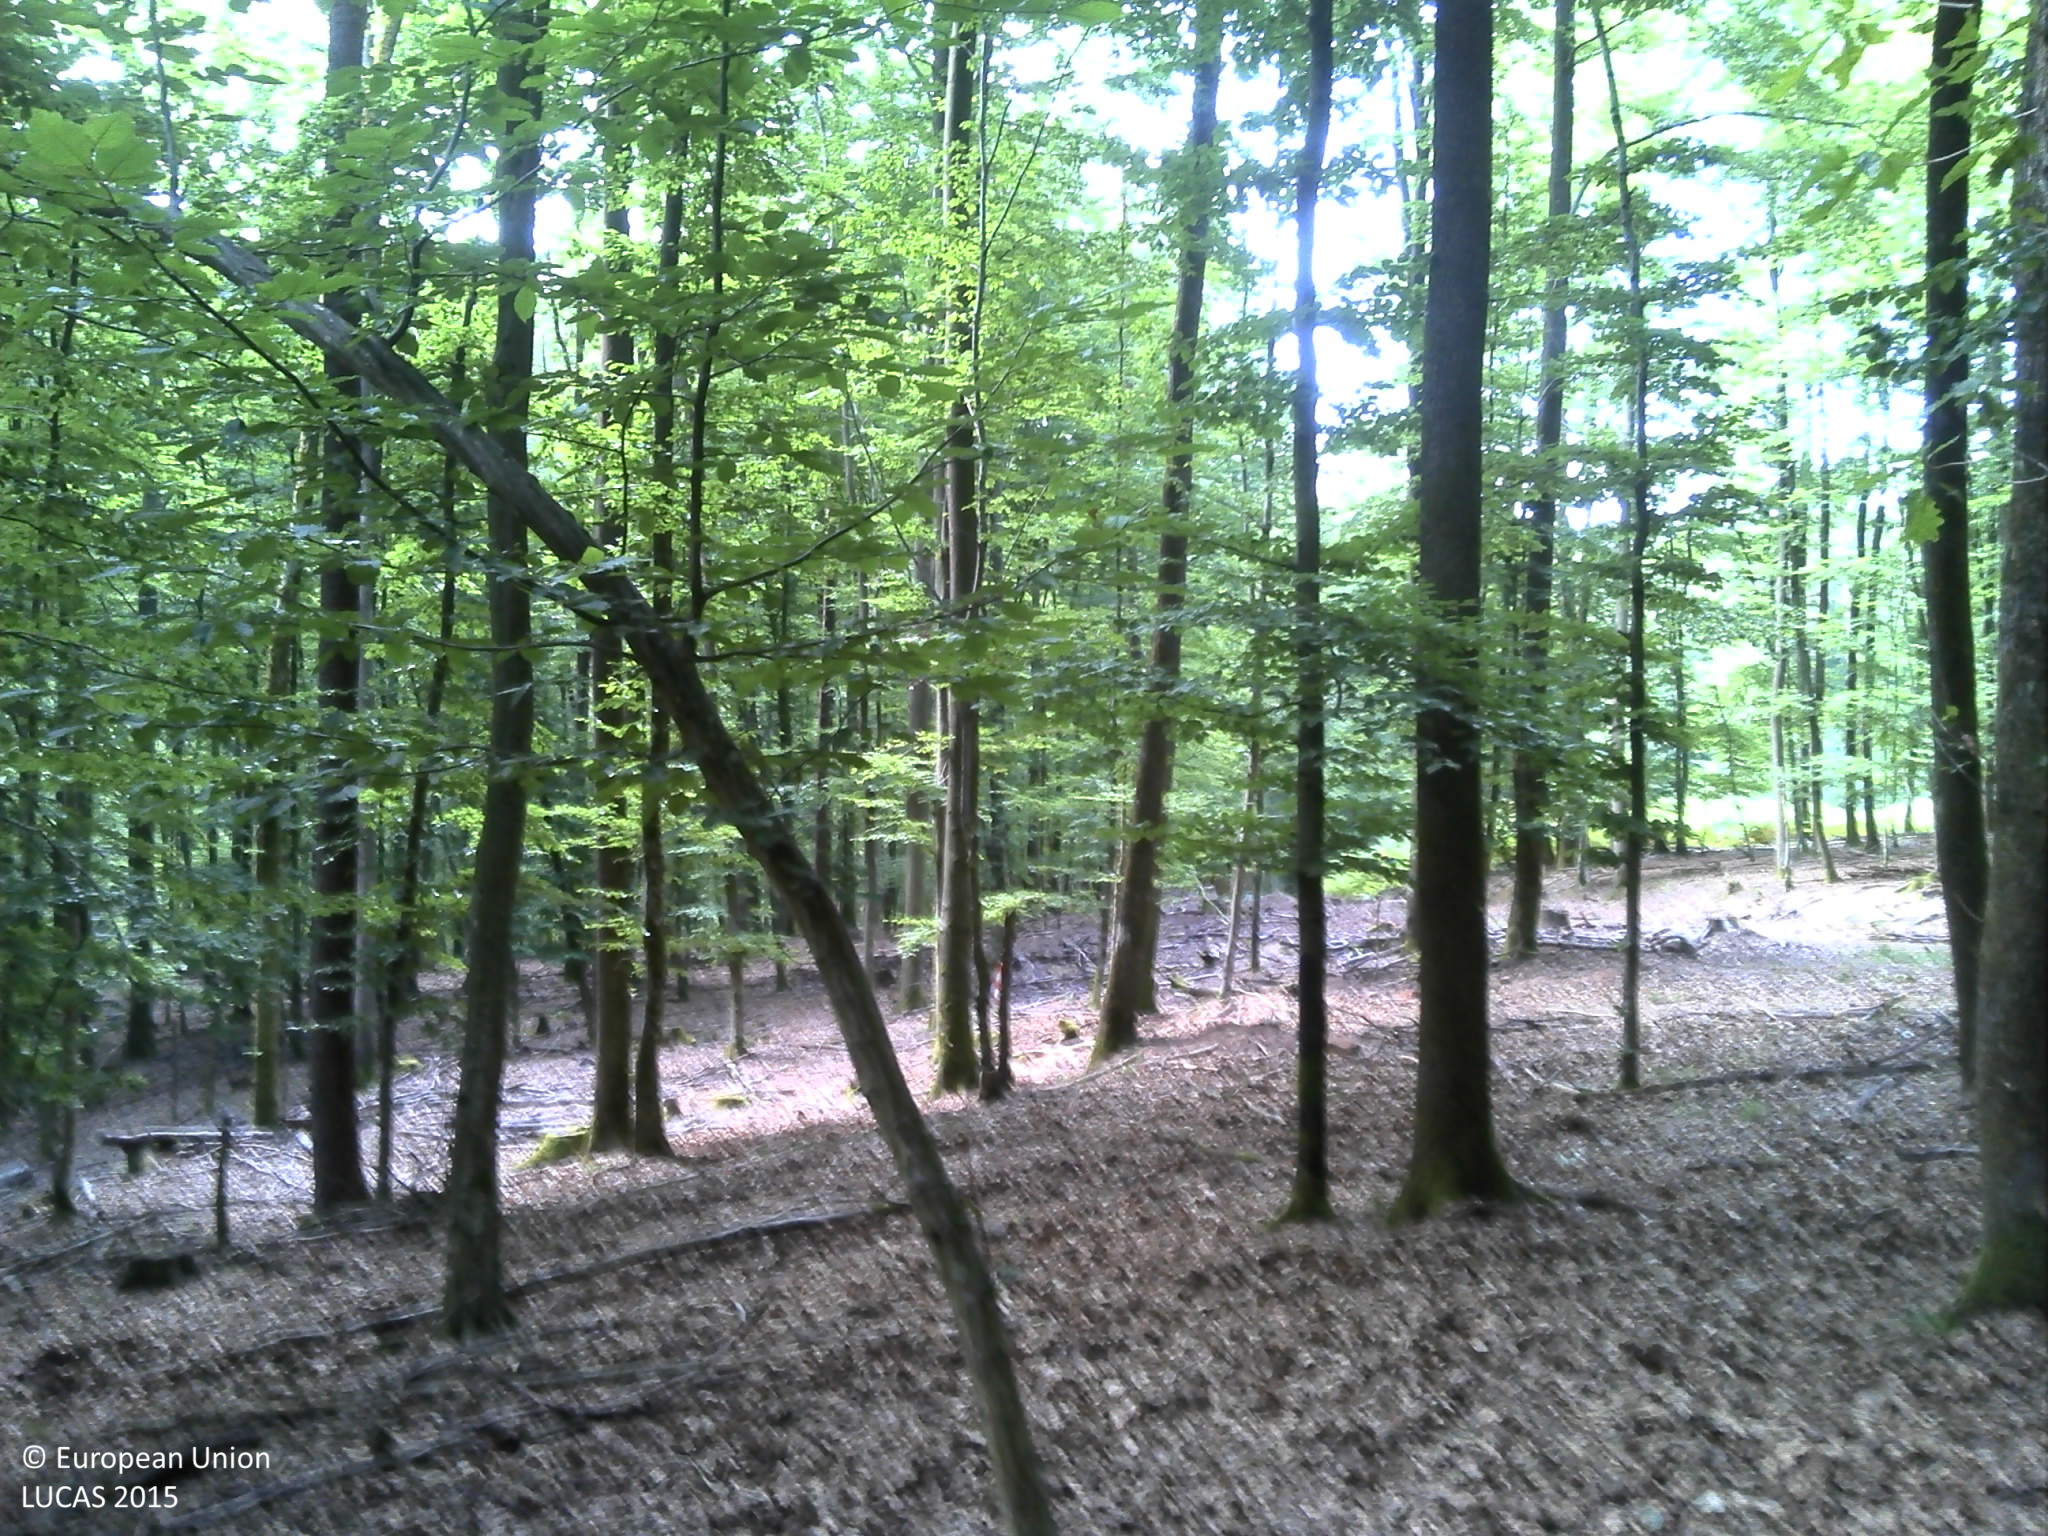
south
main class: Woodland
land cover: Broadleaved woodland
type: acidophilous oak and oak-birch forest
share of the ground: > 75 %
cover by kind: broadleaved forest trees 100 %
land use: Forestry
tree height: > 5 m
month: July
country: FR
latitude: 48.9513
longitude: 7.5017
